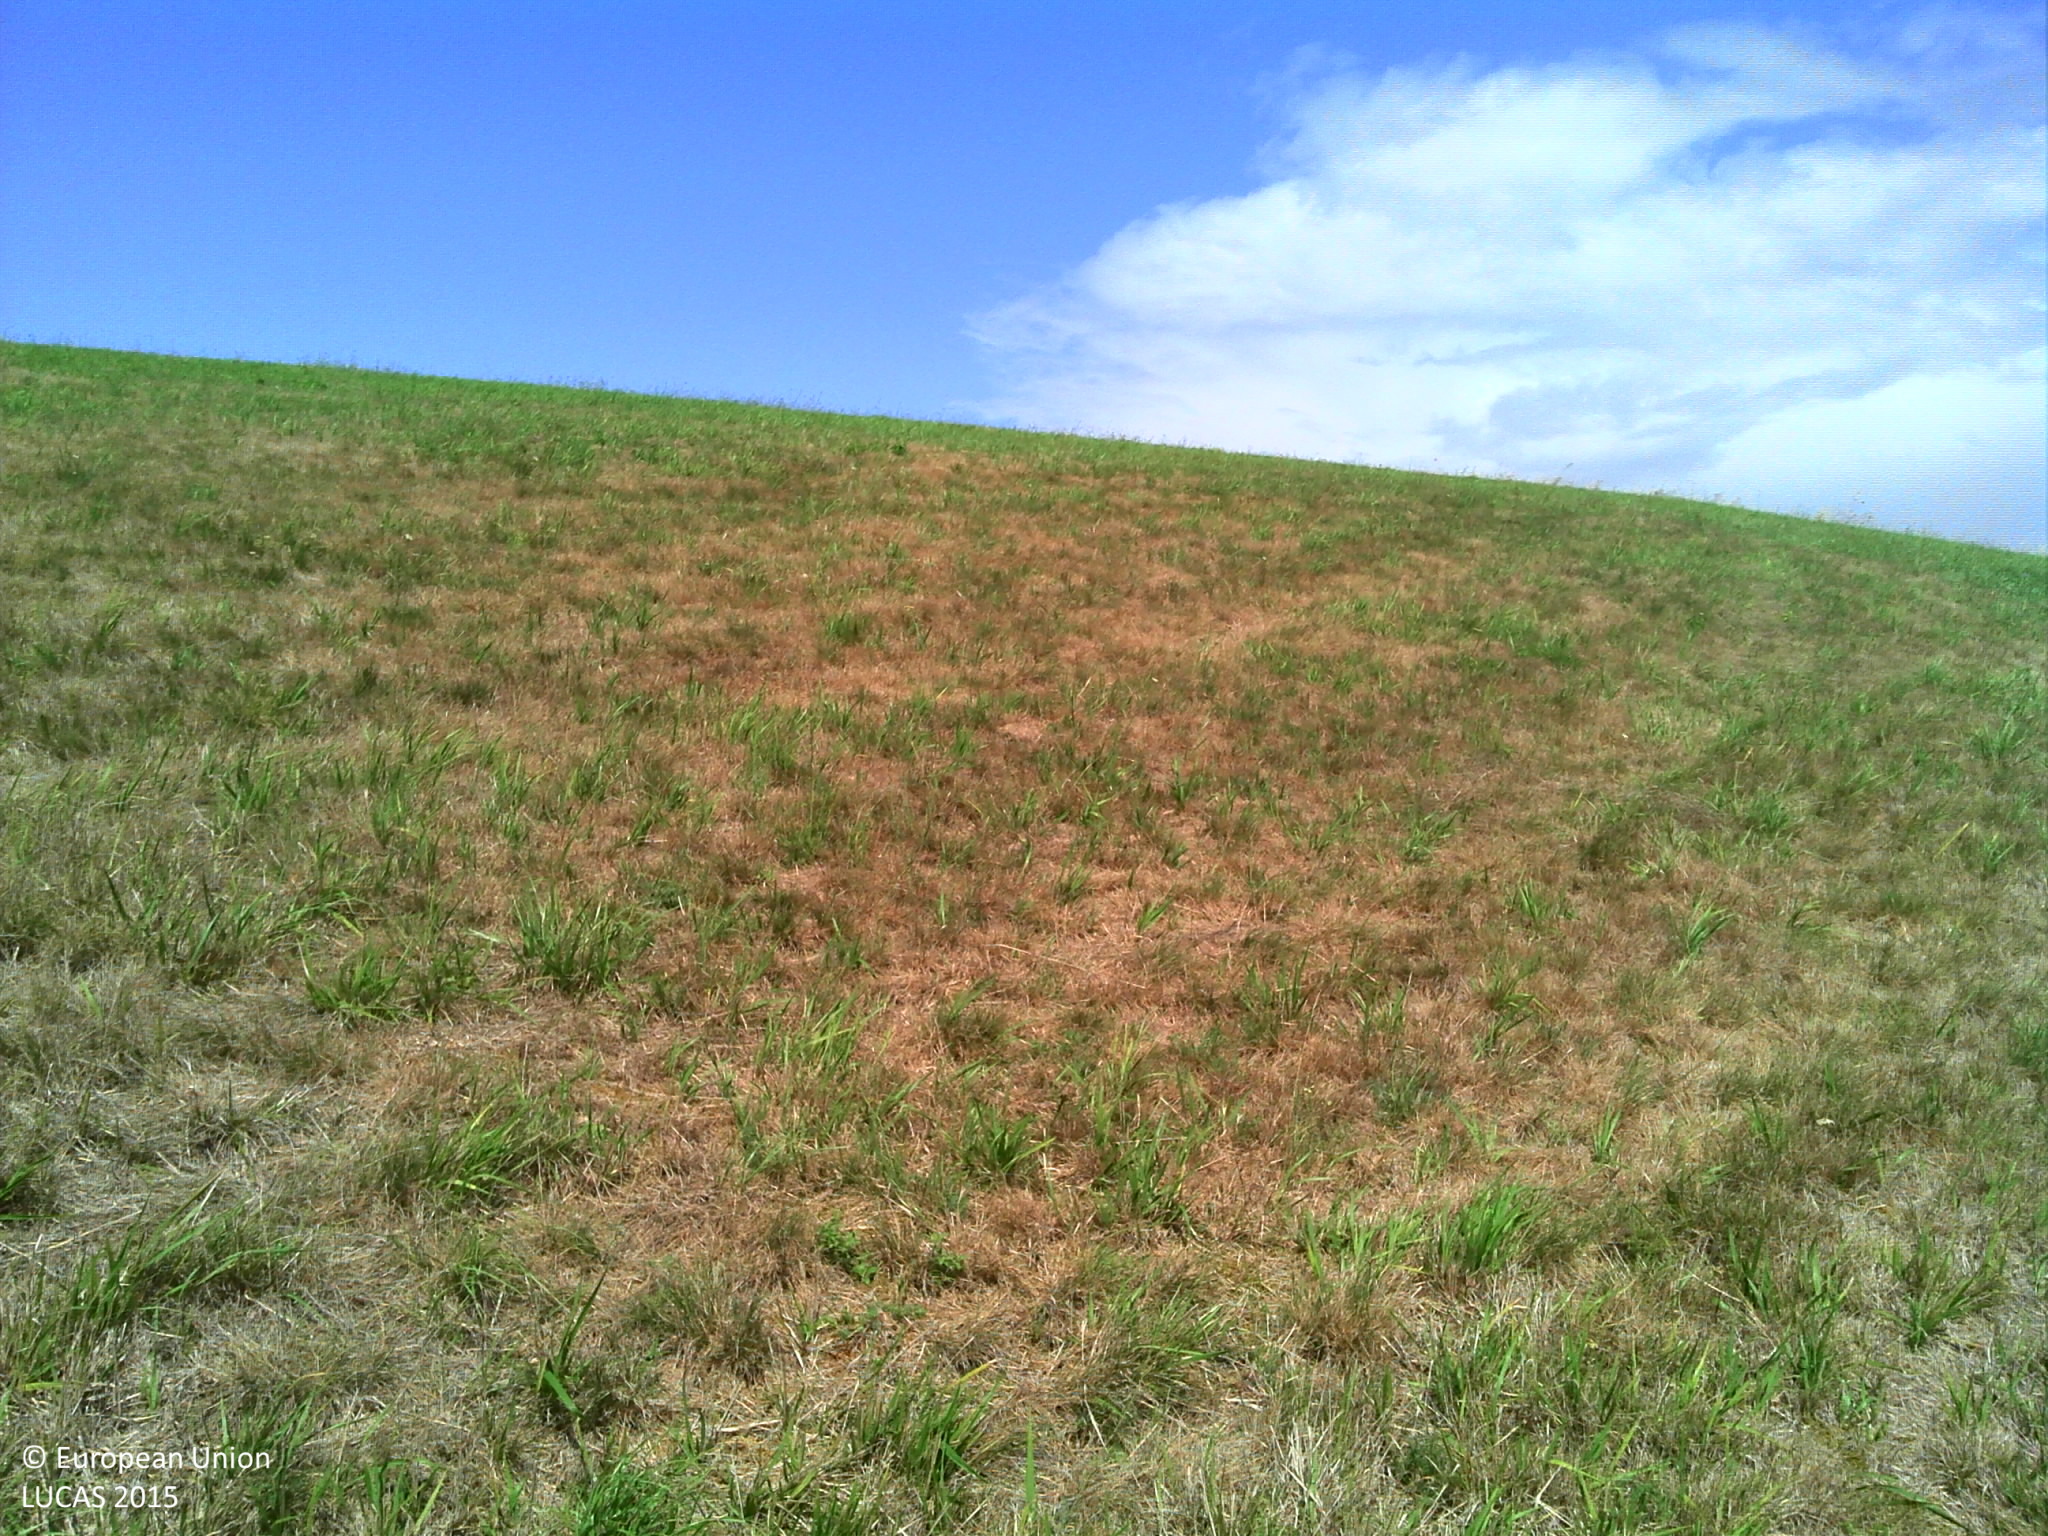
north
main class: Grassland
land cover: Grassland without tree/shrub cover
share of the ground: > 75 %
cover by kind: herbaceous plants 85 %, consolidated bare surface 10 %, lichens and mosses 5 %
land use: Agriculture (excluding fallow land and kitchen gardens)
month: August
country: FR
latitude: 45.3122
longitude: 0.7164
